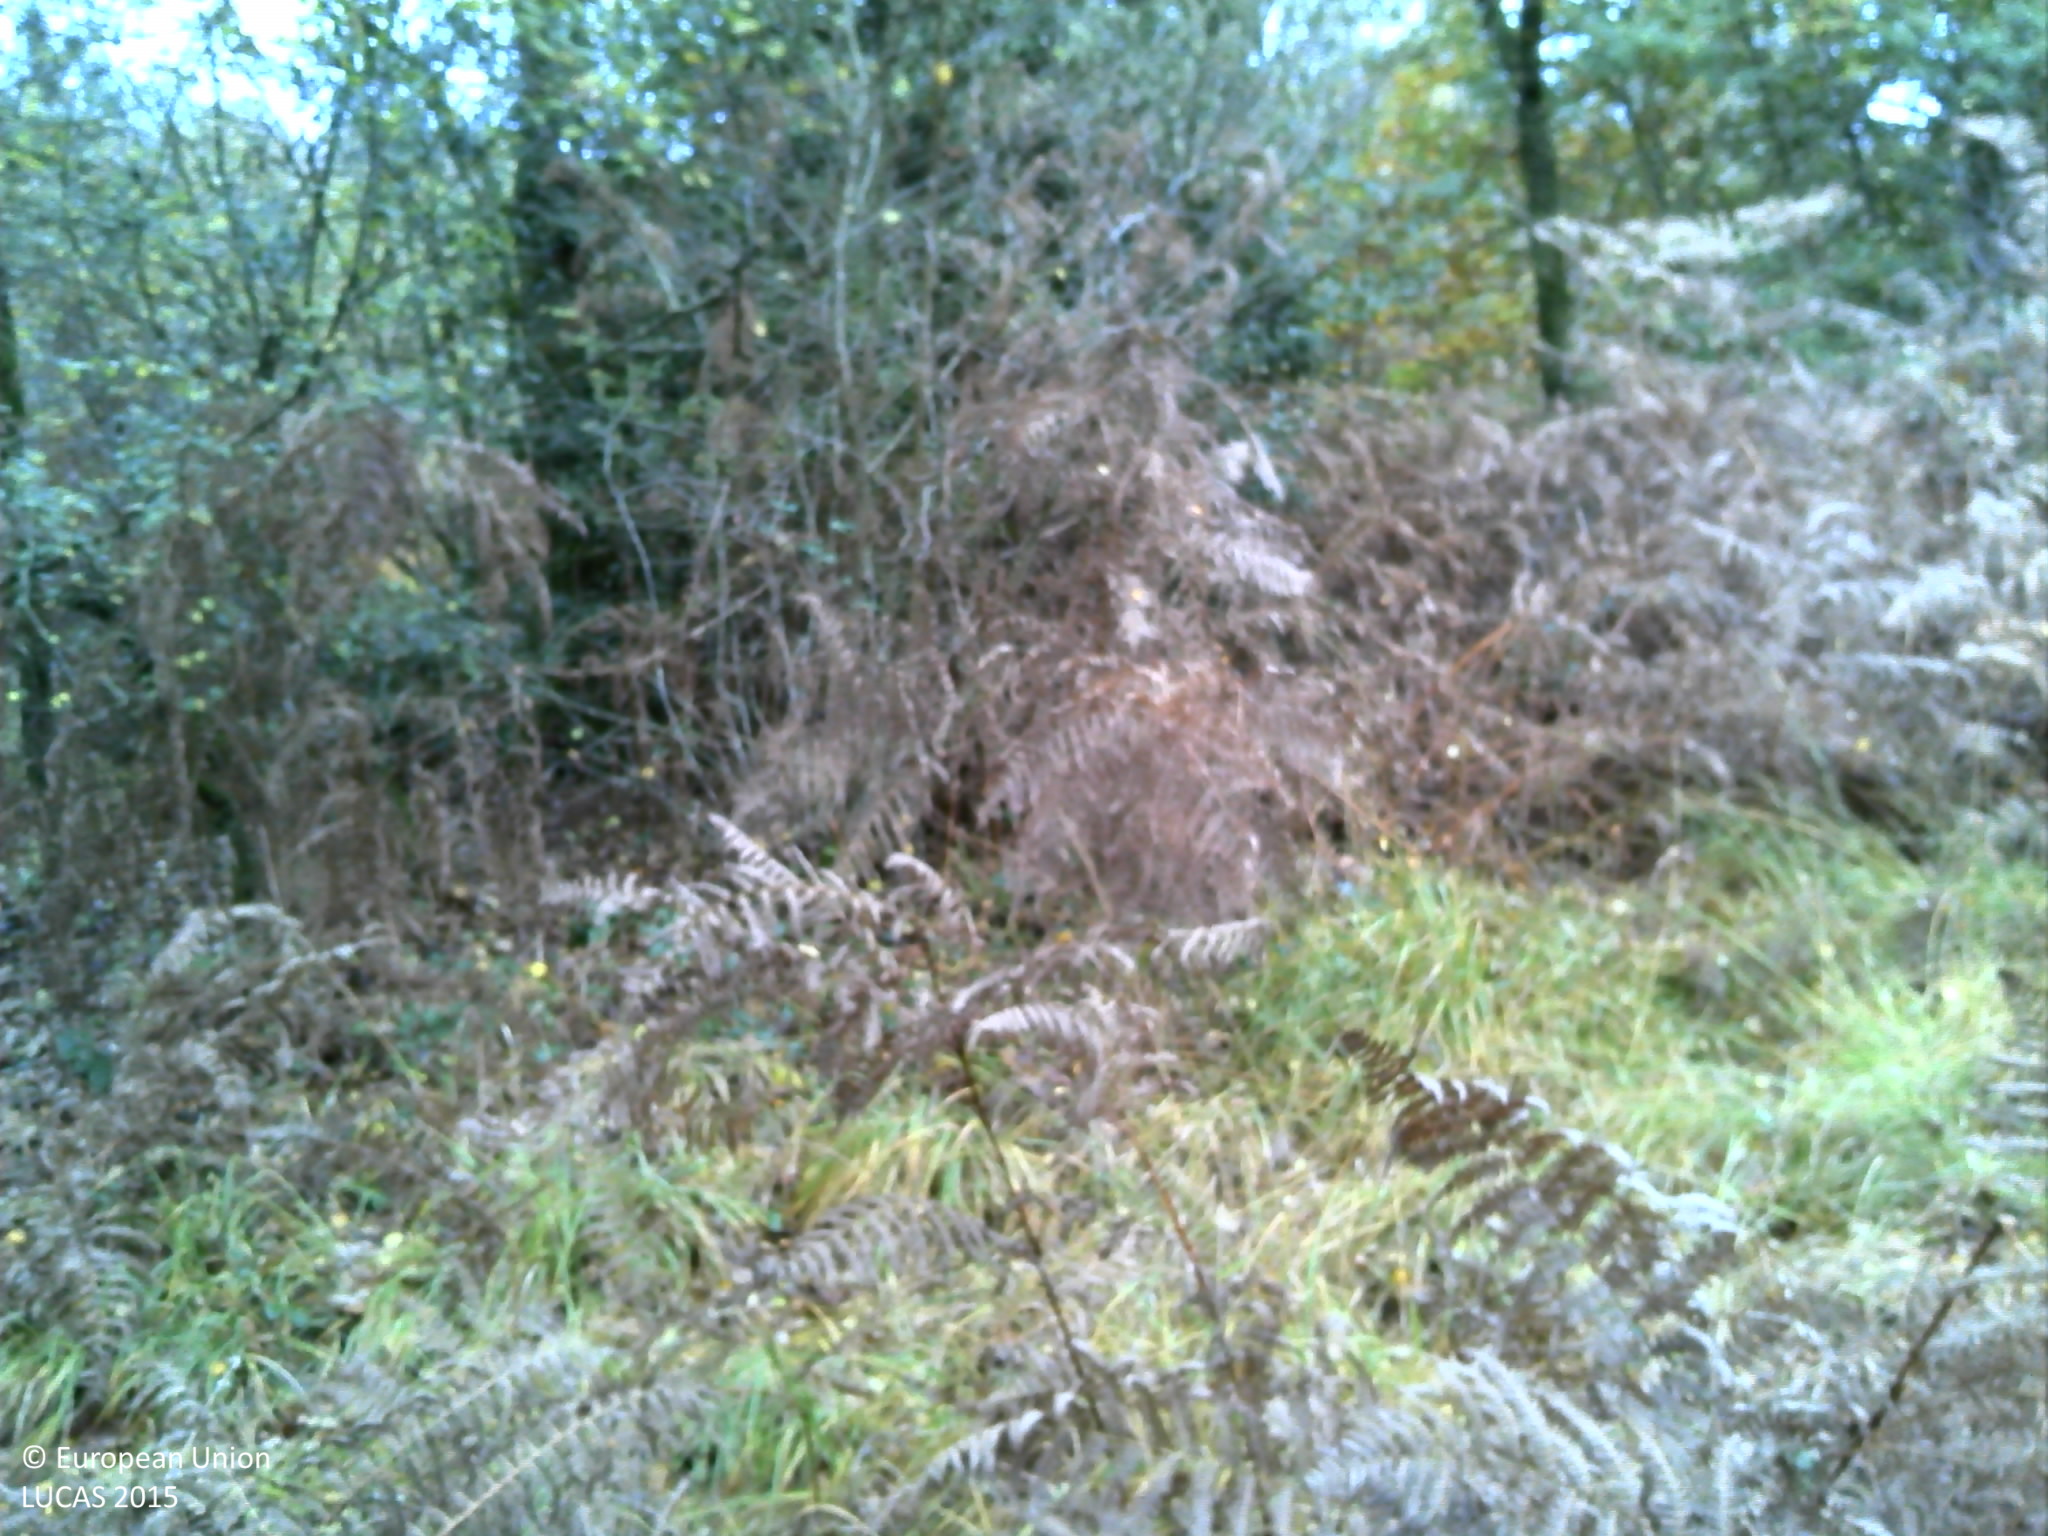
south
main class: Woodland
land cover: Broadleaved woodland
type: acidophilous oak and oak-birch forest
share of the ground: 50 - 75 %
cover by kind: broadleaved forest trees 70 %, herbaceous plants 30 %
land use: Forestry
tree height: > 5 m
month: November
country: FR
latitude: 47.6512
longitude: -1.3716
